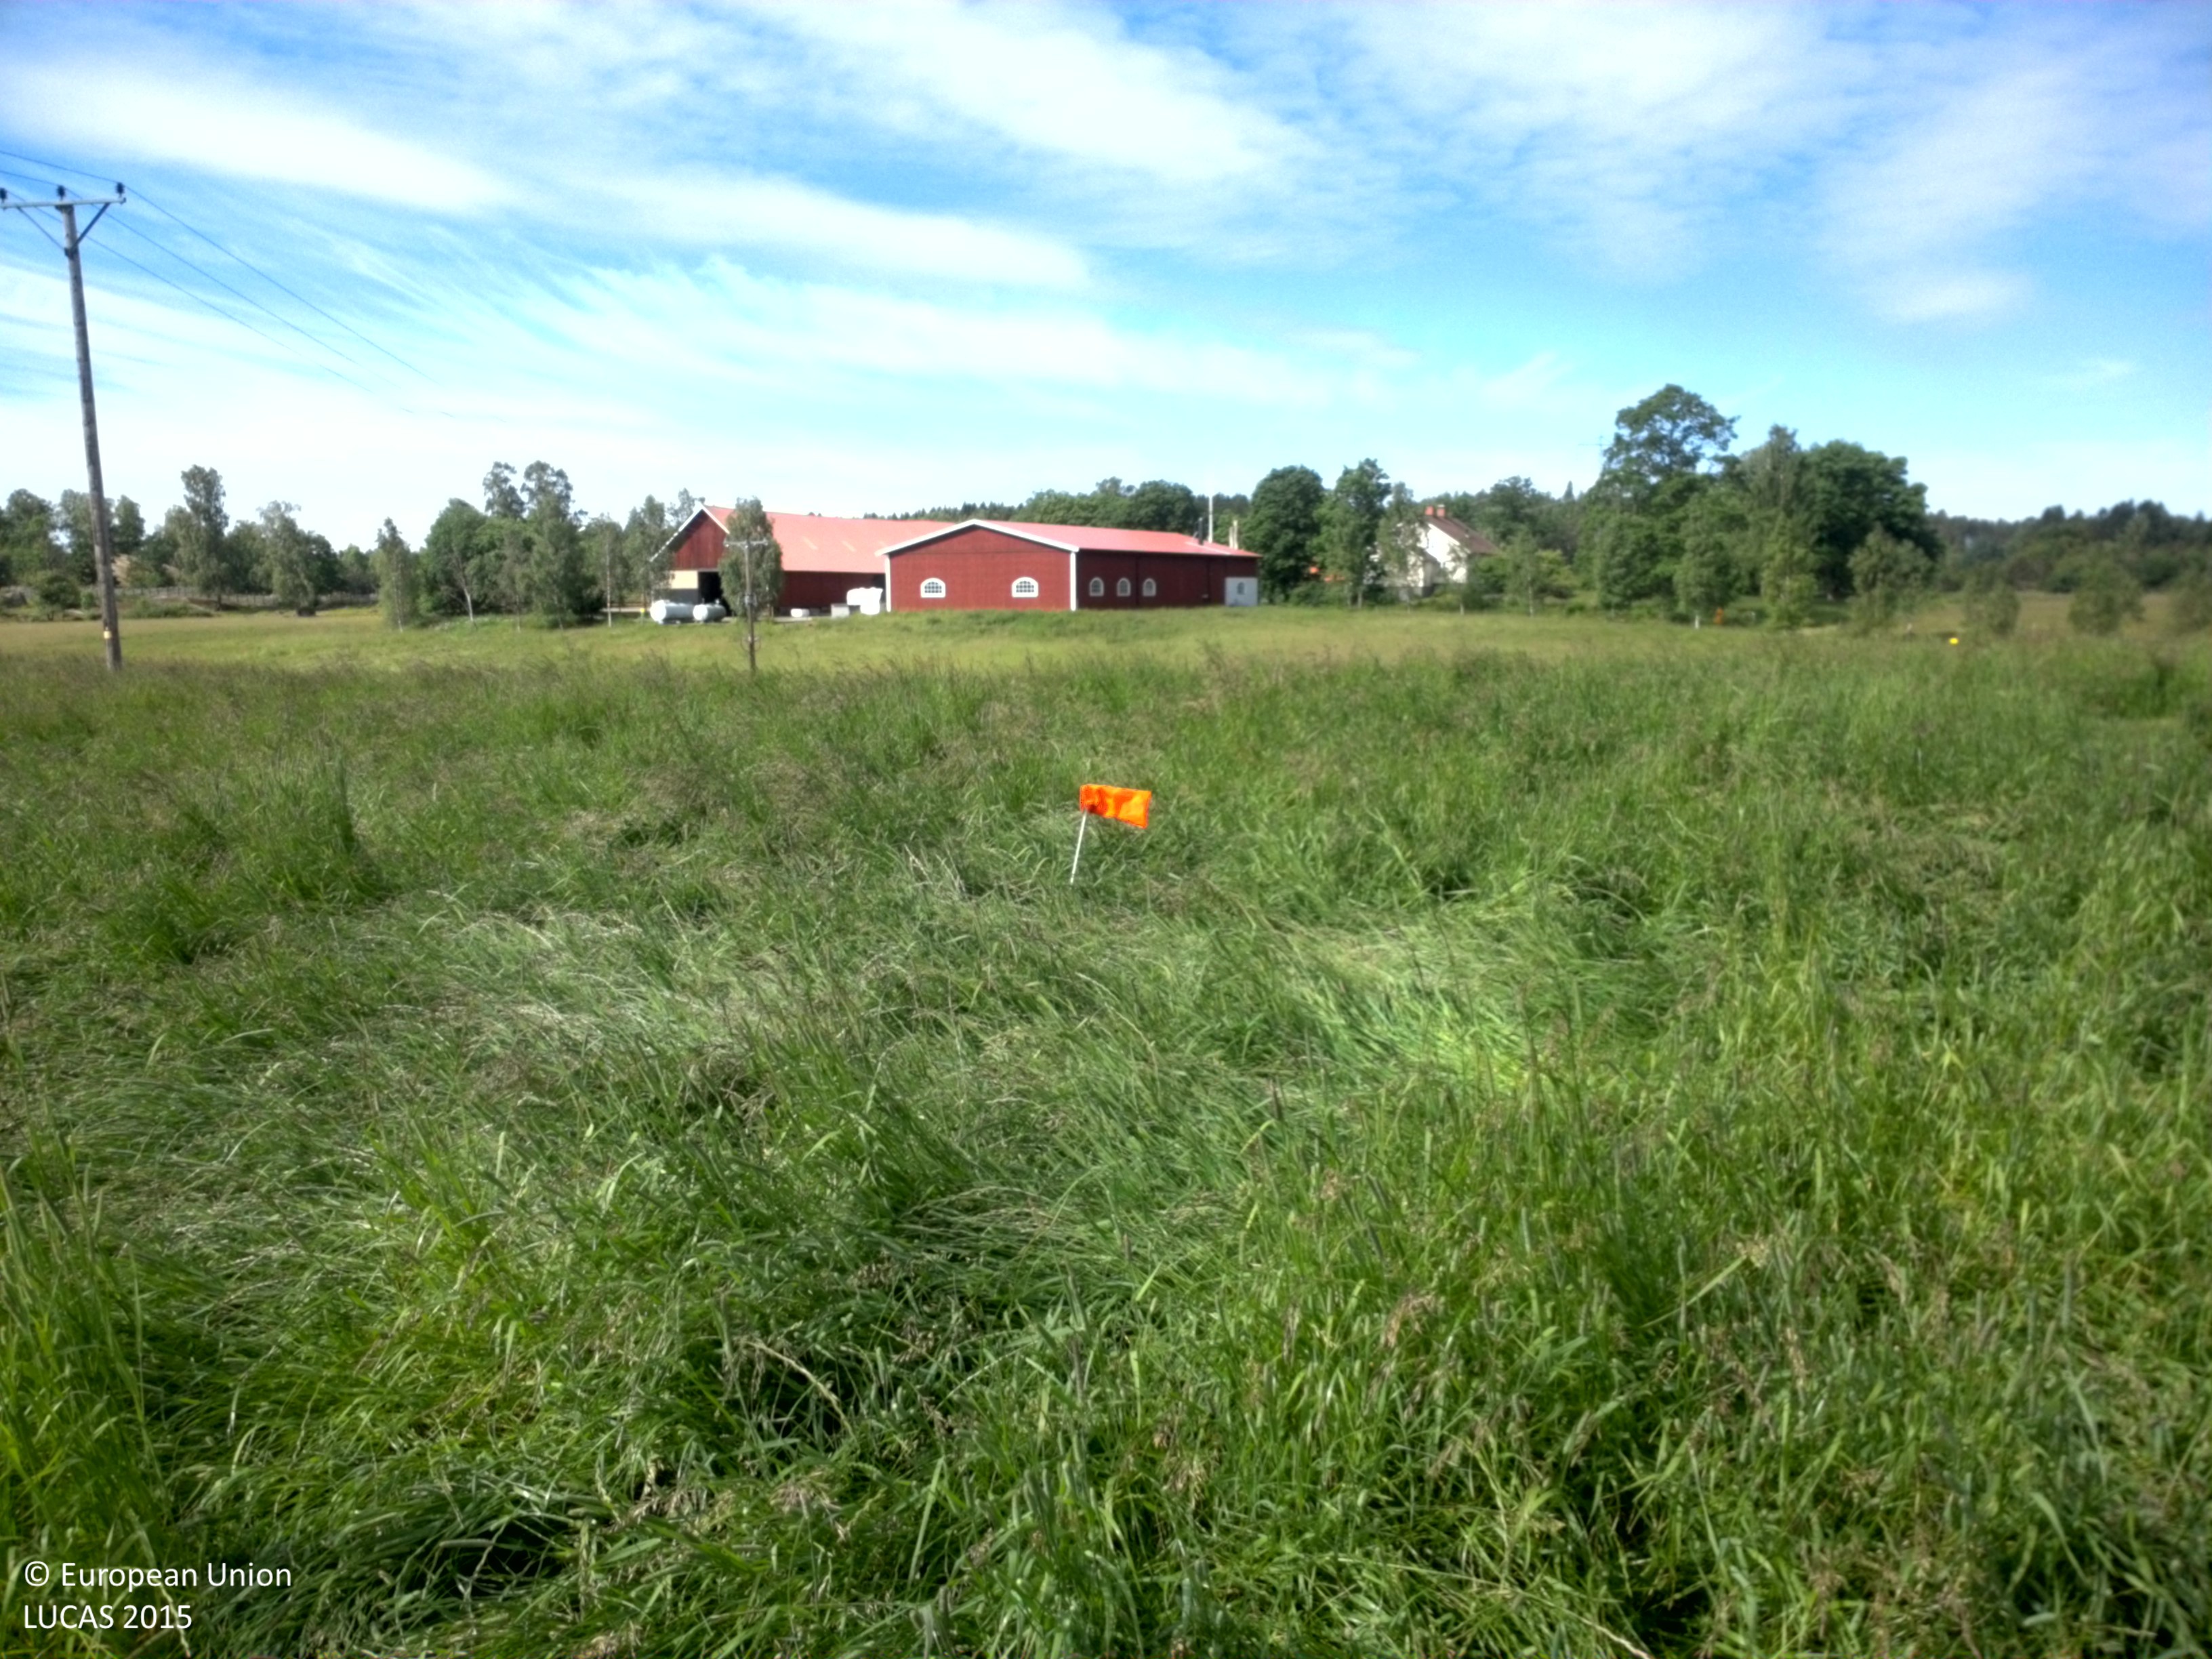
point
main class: Cropland
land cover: Temporary grasslands
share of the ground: > 75 %
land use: Agriculture (excluding fallow land and kitchen gardens)
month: June
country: SE
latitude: 58.5395
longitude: 15.5084
